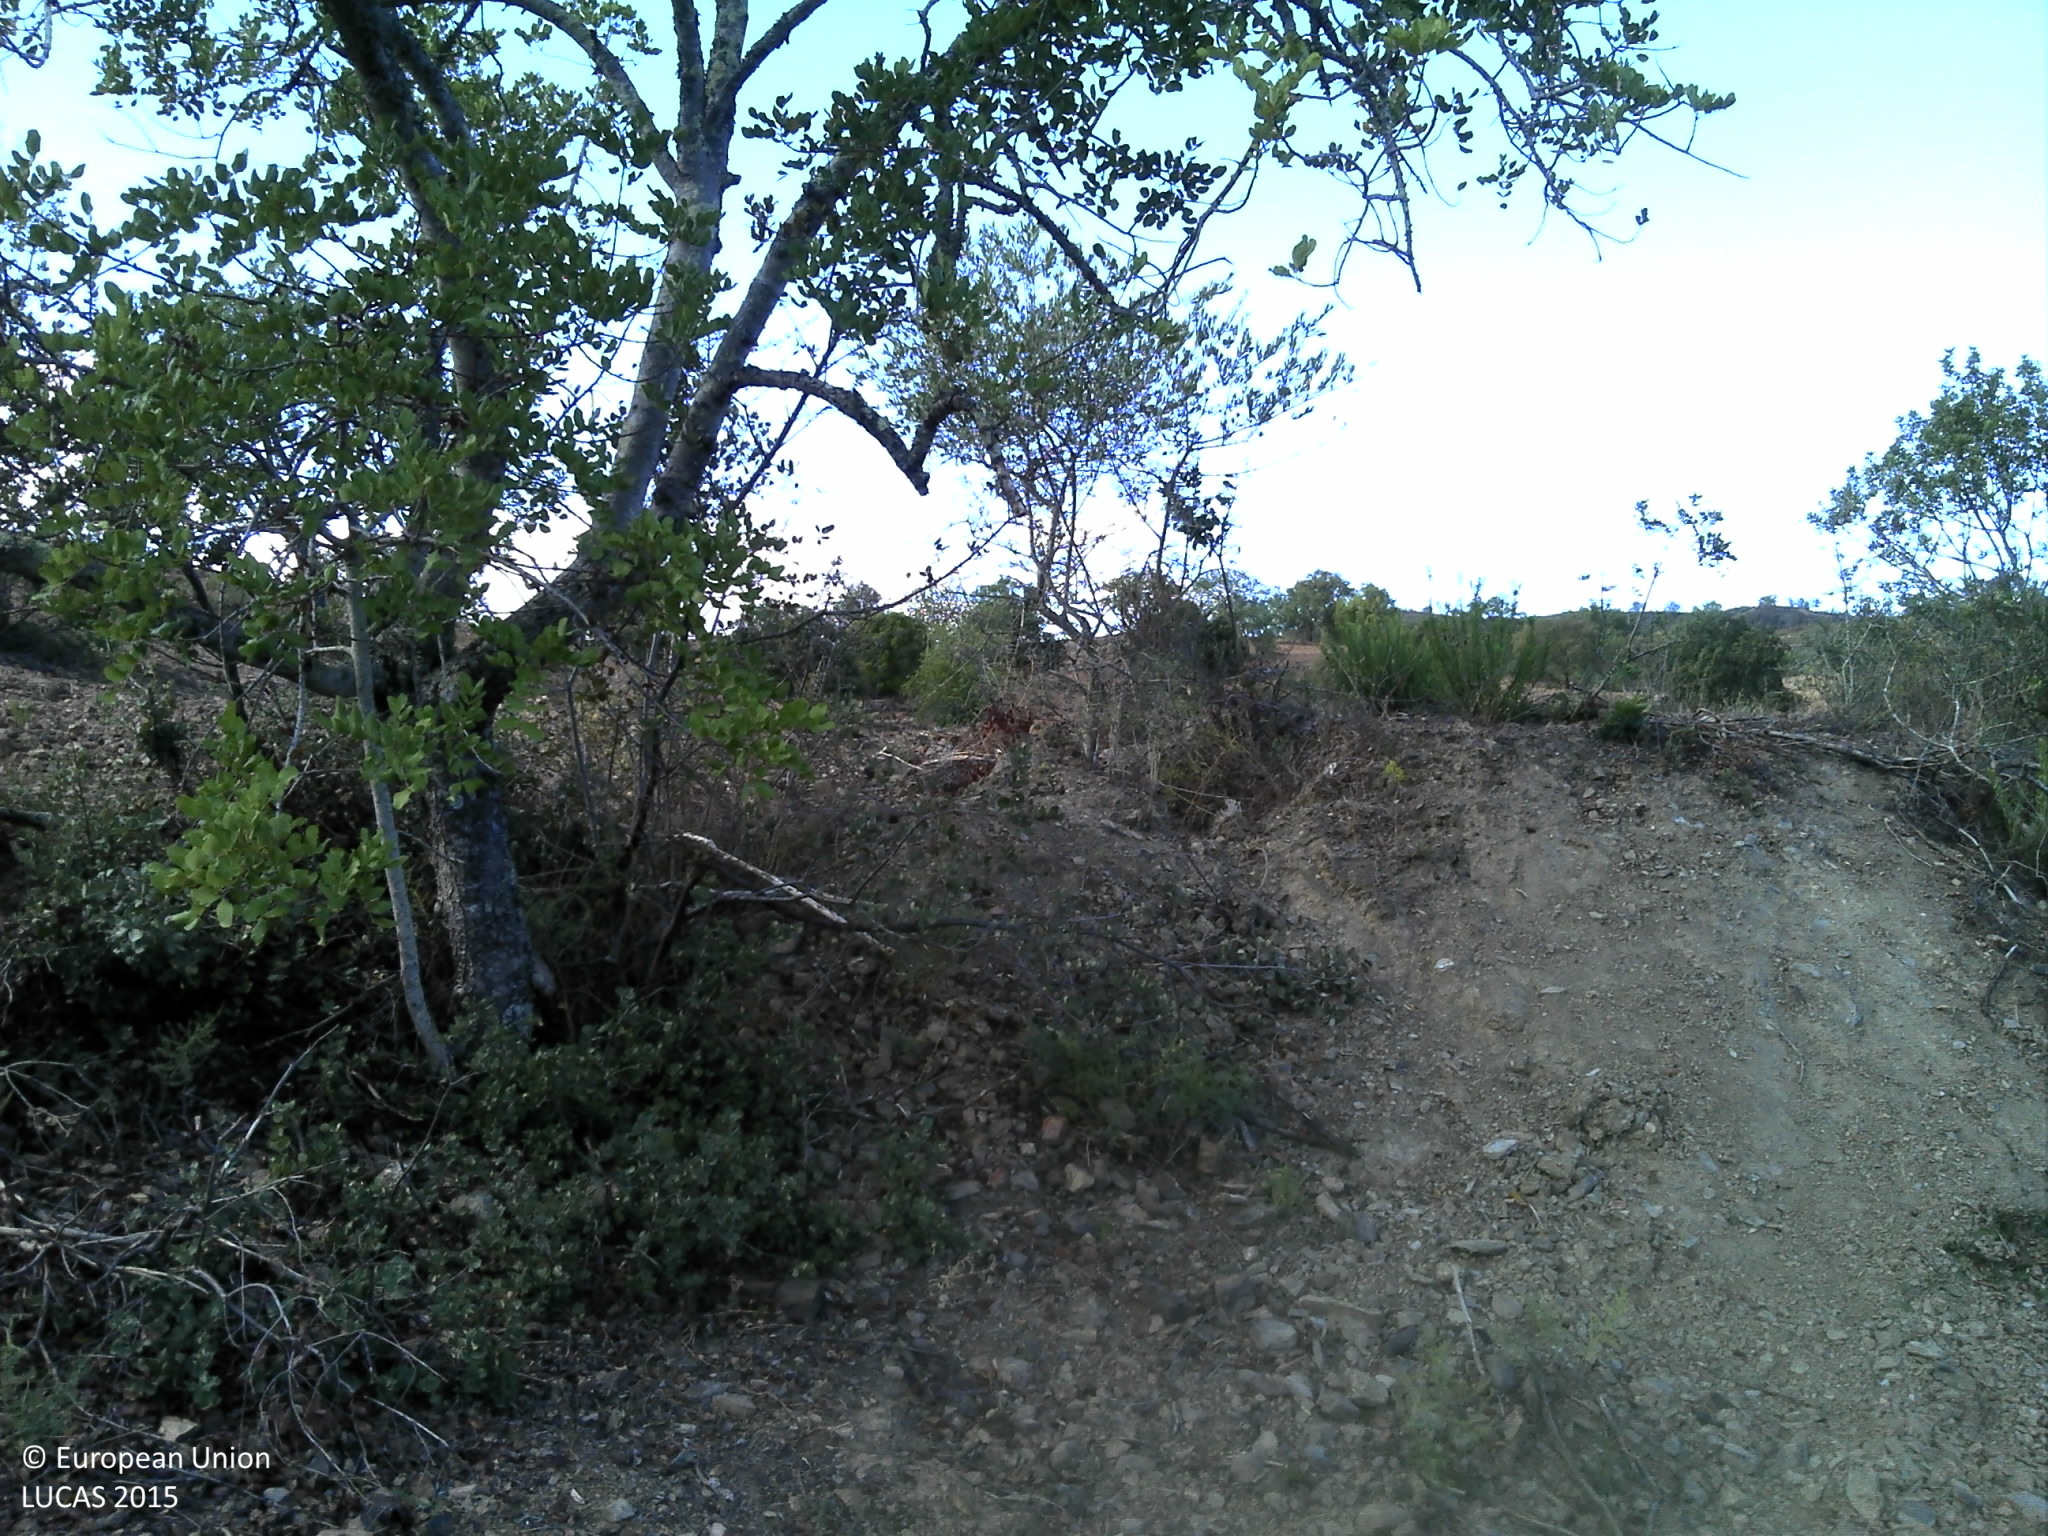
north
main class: Shrubland
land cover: Shrubland with sparse tree cover
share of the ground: 10 - 25 %
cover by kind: unconsolidated bare surface 65 %, shrubs 20 %, herbaceous plants 10 %, broadleaved forest trees 5 %
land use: Agriculture (excluding fallow land and kitchen gardens)
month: September
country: PT
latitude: 37.2566
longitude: -8.1836
